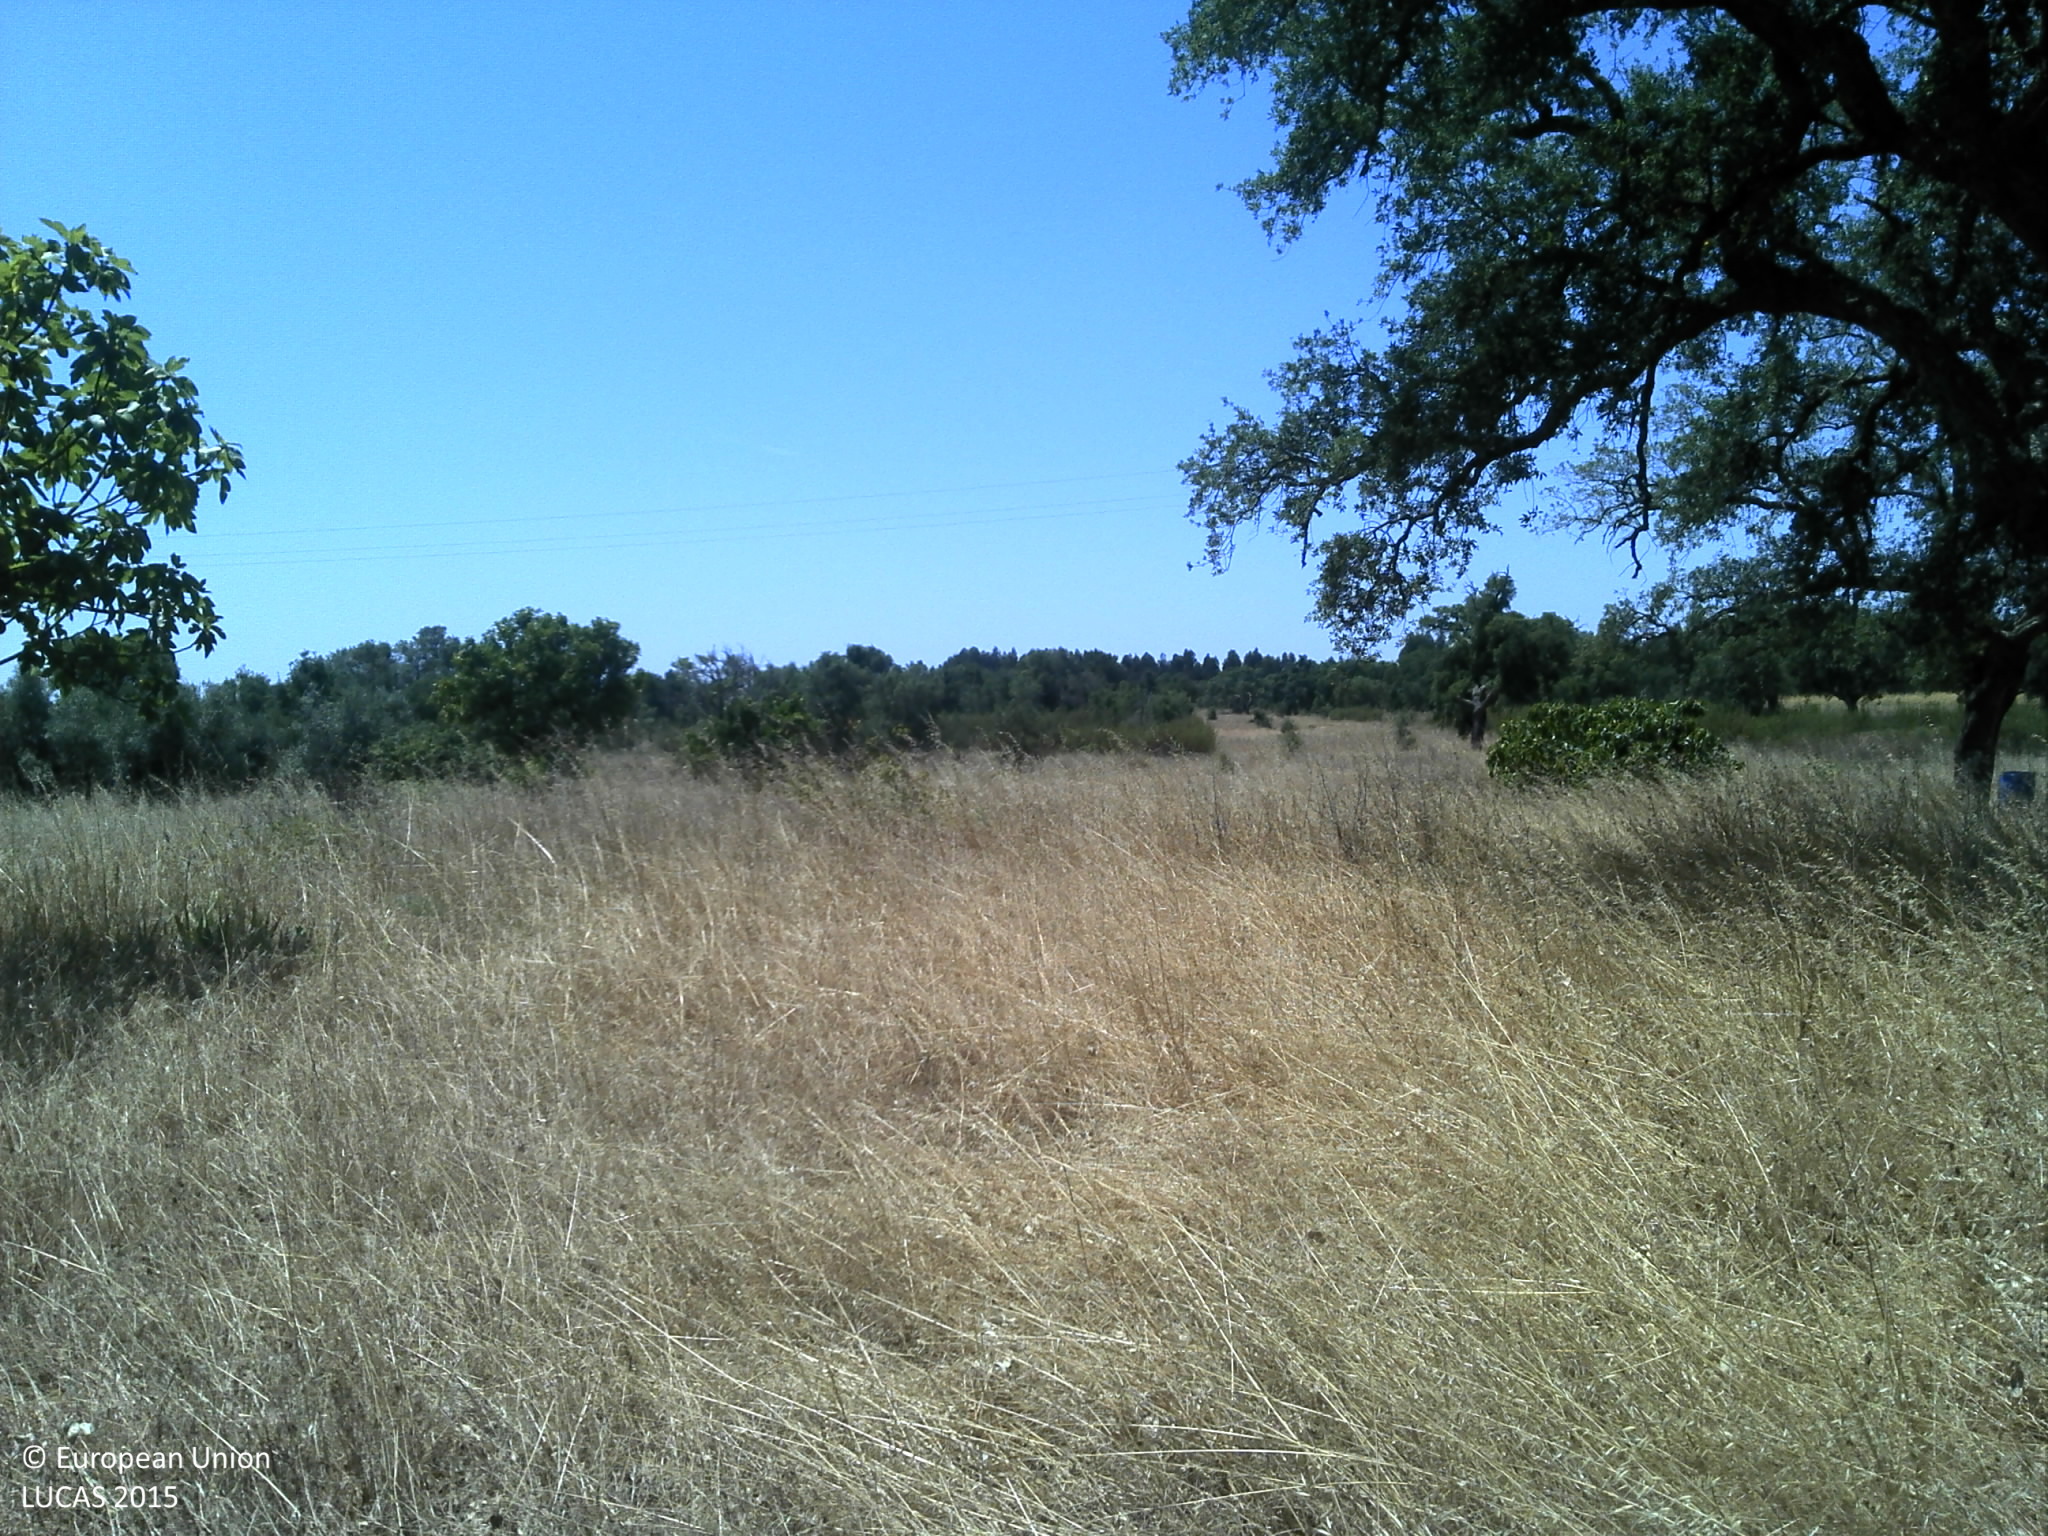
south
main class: Cropland
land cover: Olive groves
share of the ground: 25 - 50 %
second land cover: Grassland without tree/shrub cover
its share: 25 - 50 %
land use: Agriculture (excluding fallow land and kitchen gardens)
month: June
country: PT
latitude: 39.0733
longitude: -8.6430
